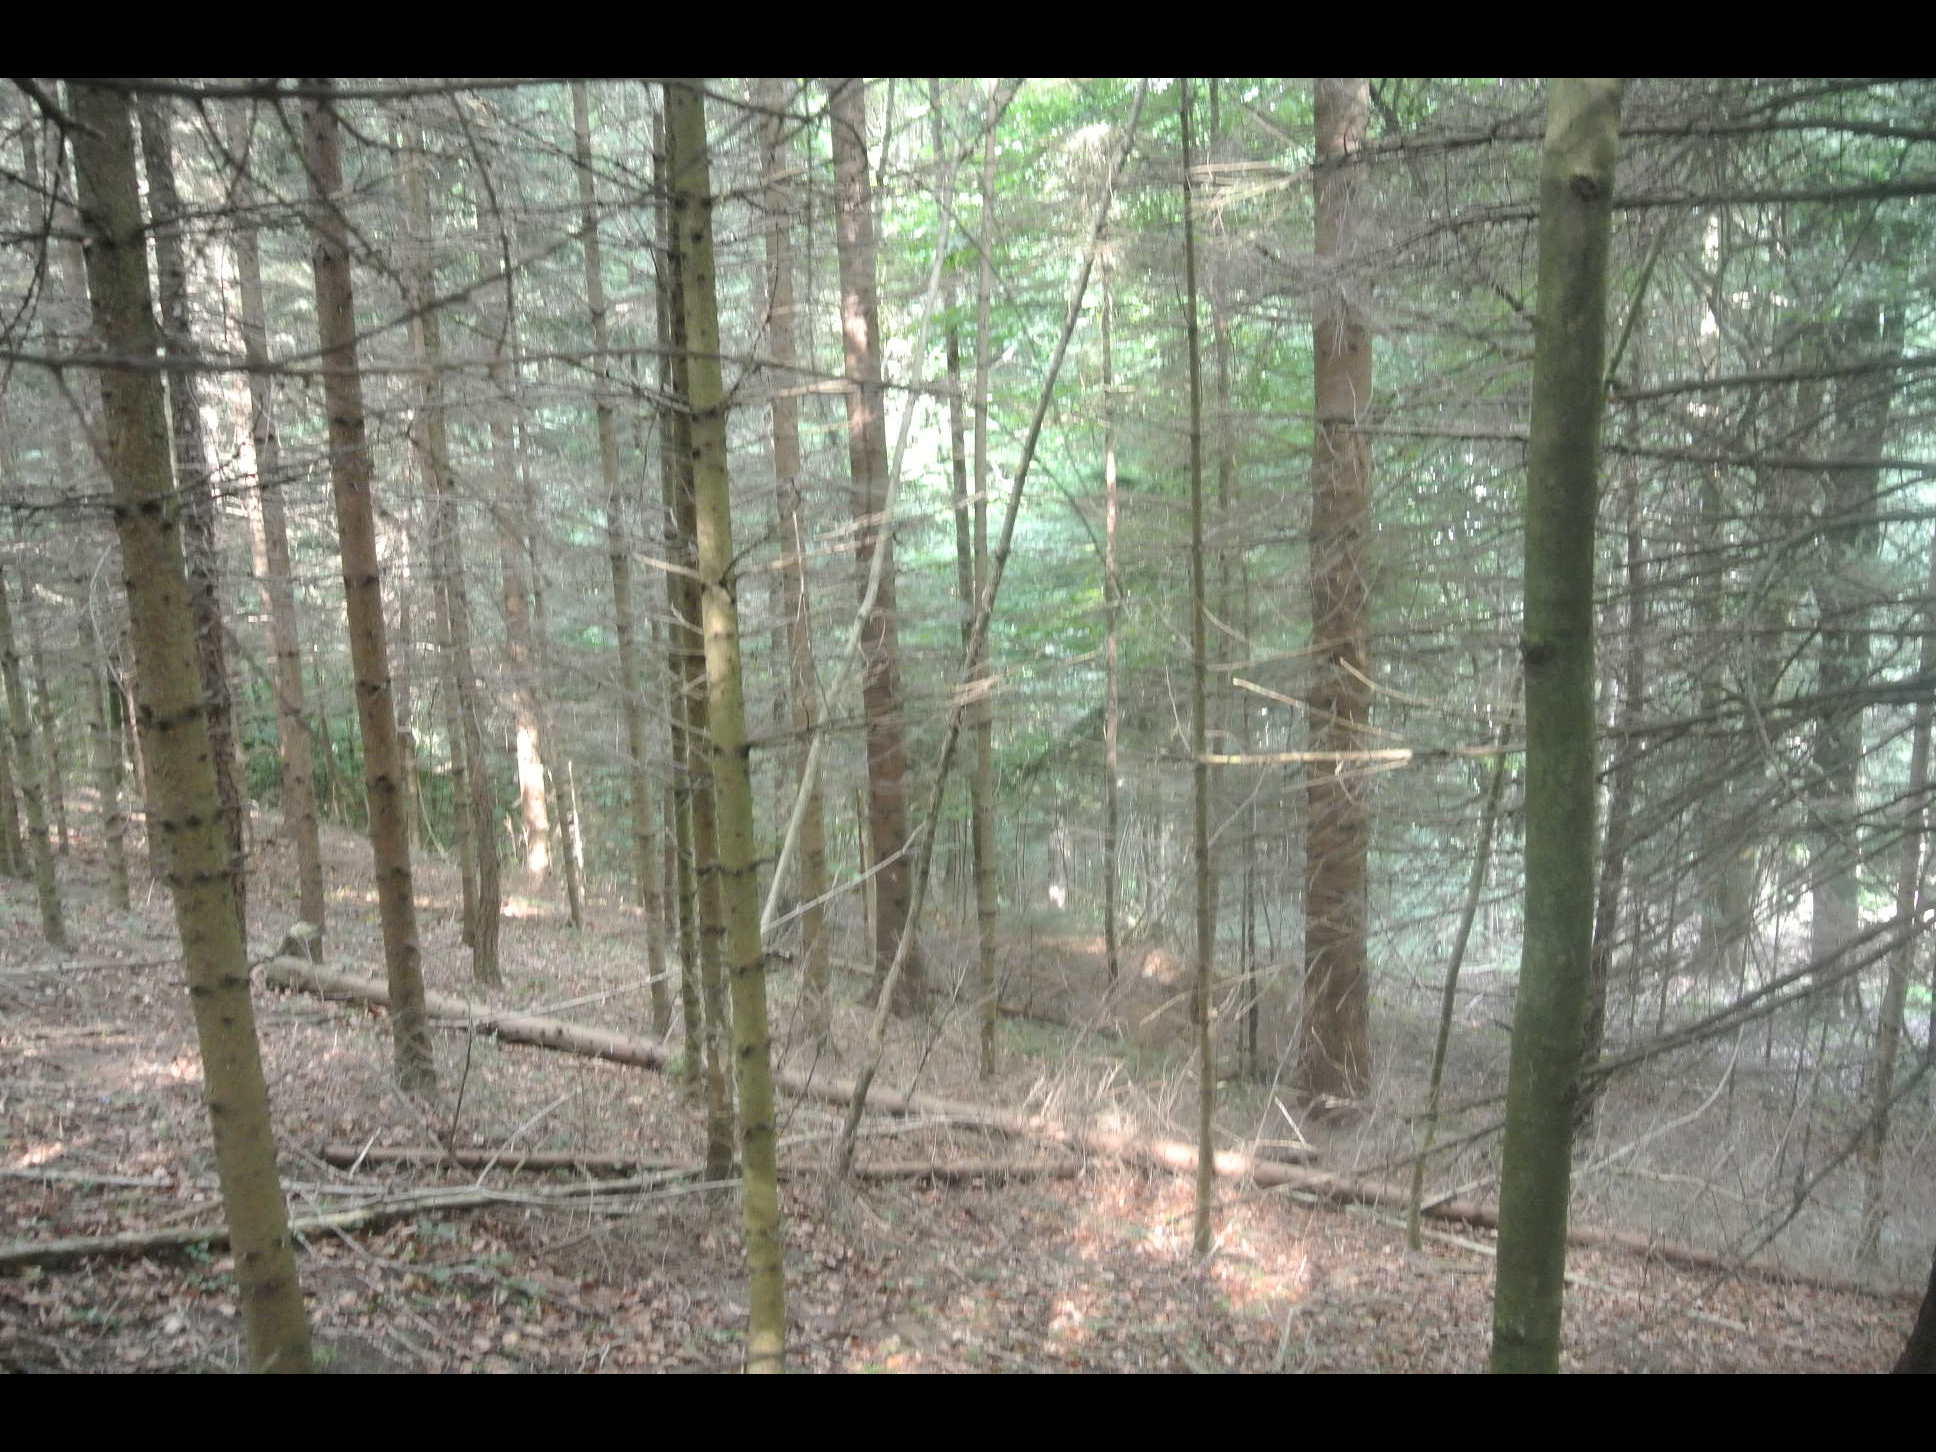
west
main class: Woodland
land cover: Spruce dominated mixed woodland
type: alpine coniferous forest
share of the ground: > 75 %
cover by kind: coniferous forest trees 70 %, broadleaved forest trees 30 %
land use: Forestry
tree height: > 5 m
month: July
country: AT
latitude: 48.0189
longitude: 15.4049
